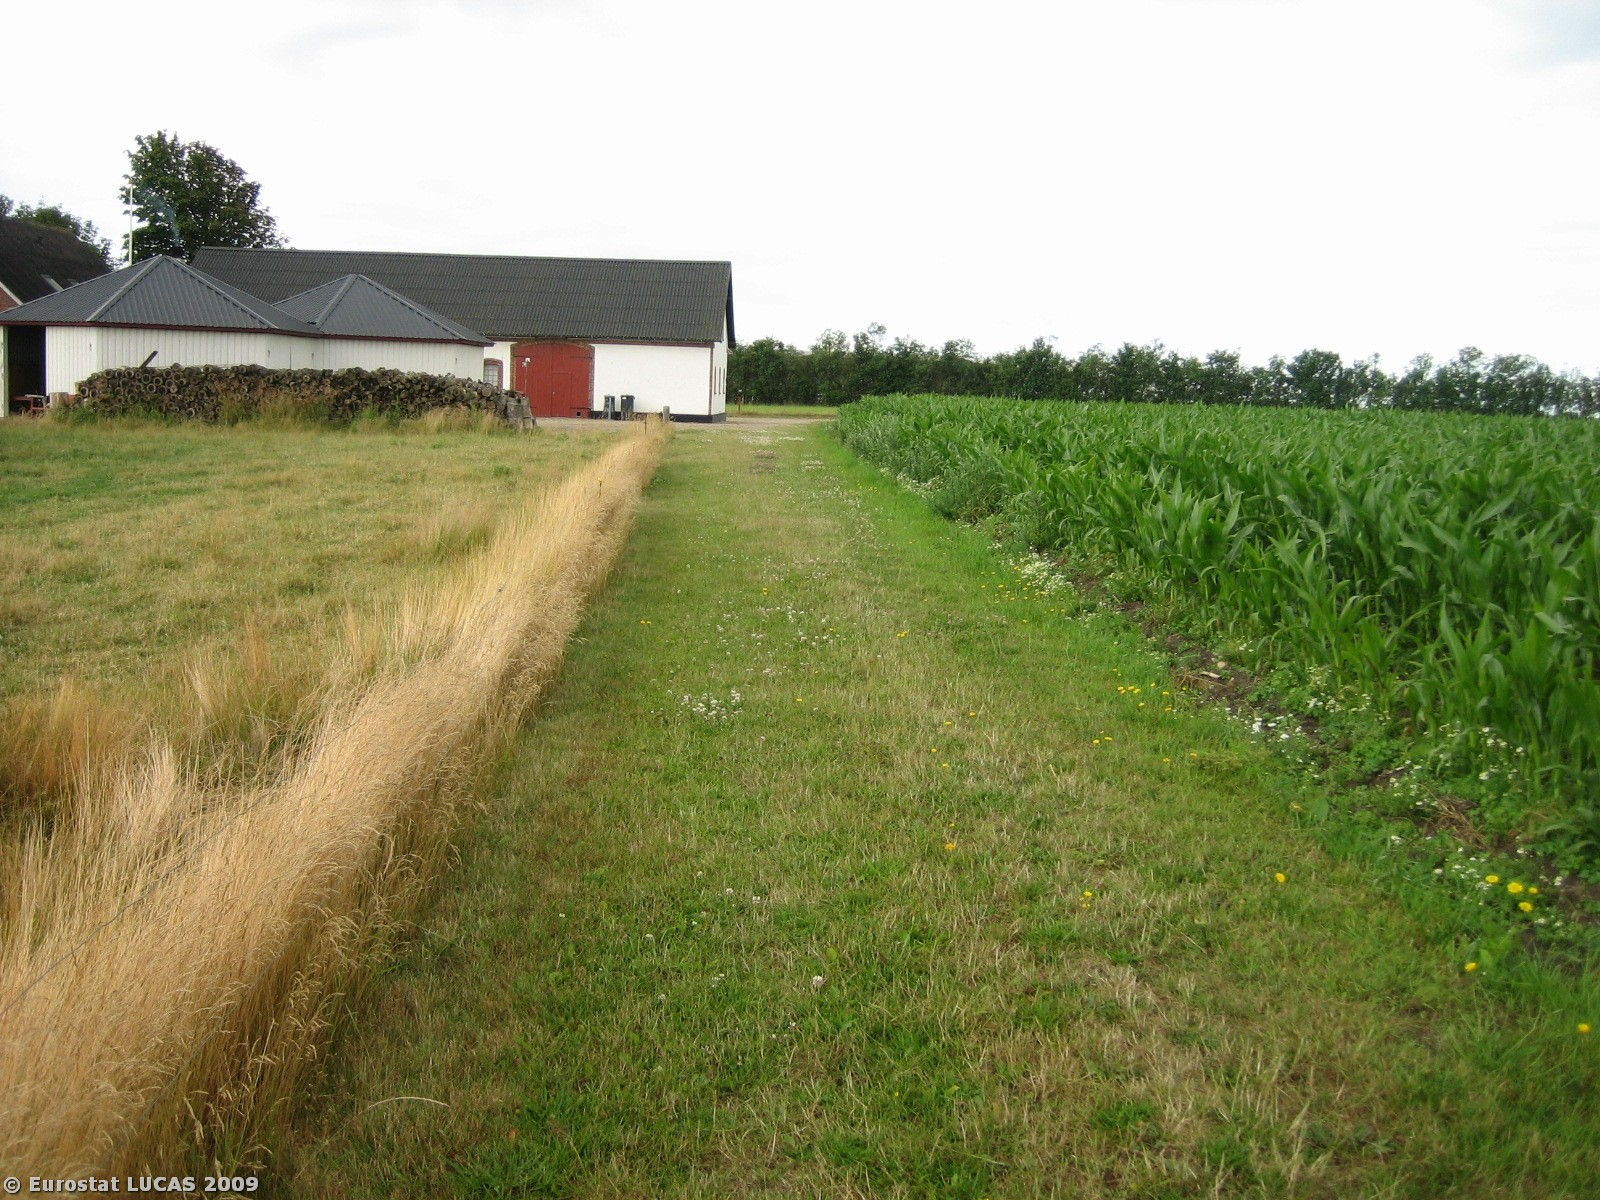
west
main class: Grassland
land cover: Grassland without tree/shrub cover
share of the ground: > 75 %
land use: Agriculture (excluding fallow land and kitchen gardens)
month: July
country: DK
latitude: 55.7638
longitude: 8.3600
